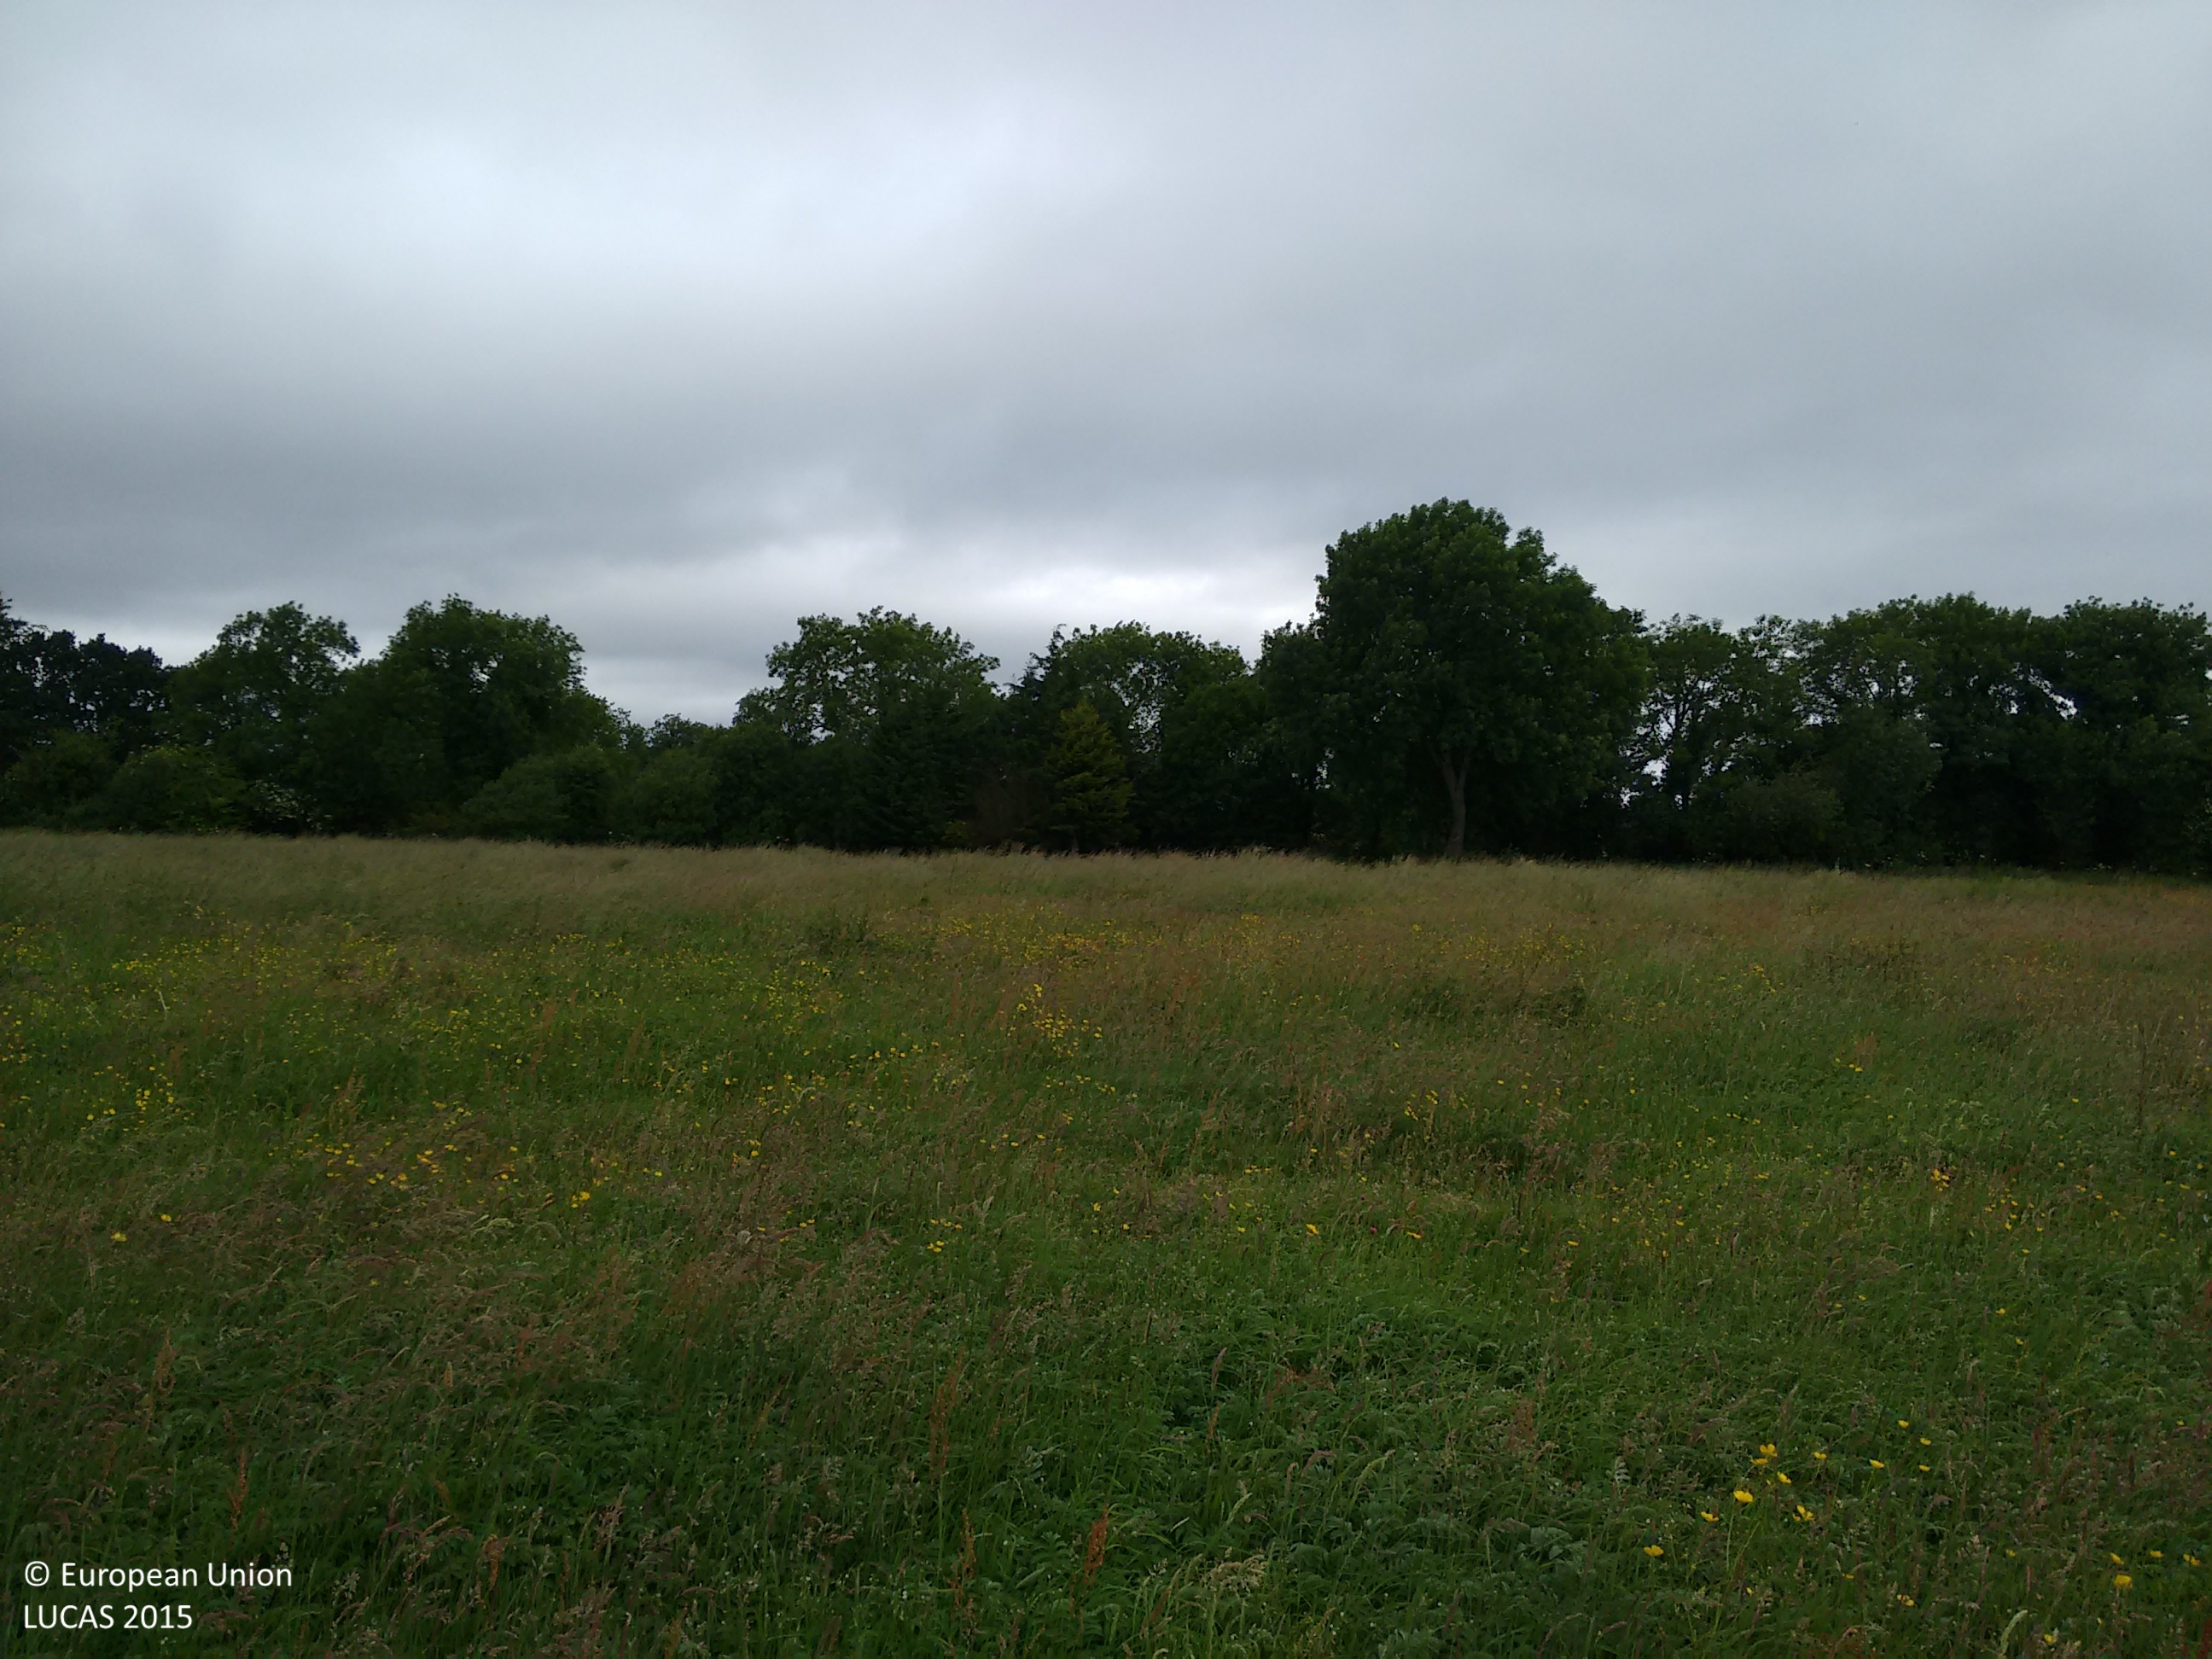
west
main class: Grassland
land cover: Spontaneously vegetated surfaces
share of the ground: > 75 %
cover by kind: herbaceous plants 95 %, shrubs 5 %
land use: Abandoned areas
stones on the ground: < 10 %
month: June
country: IE
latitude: 53.3897
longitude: -7.7128
